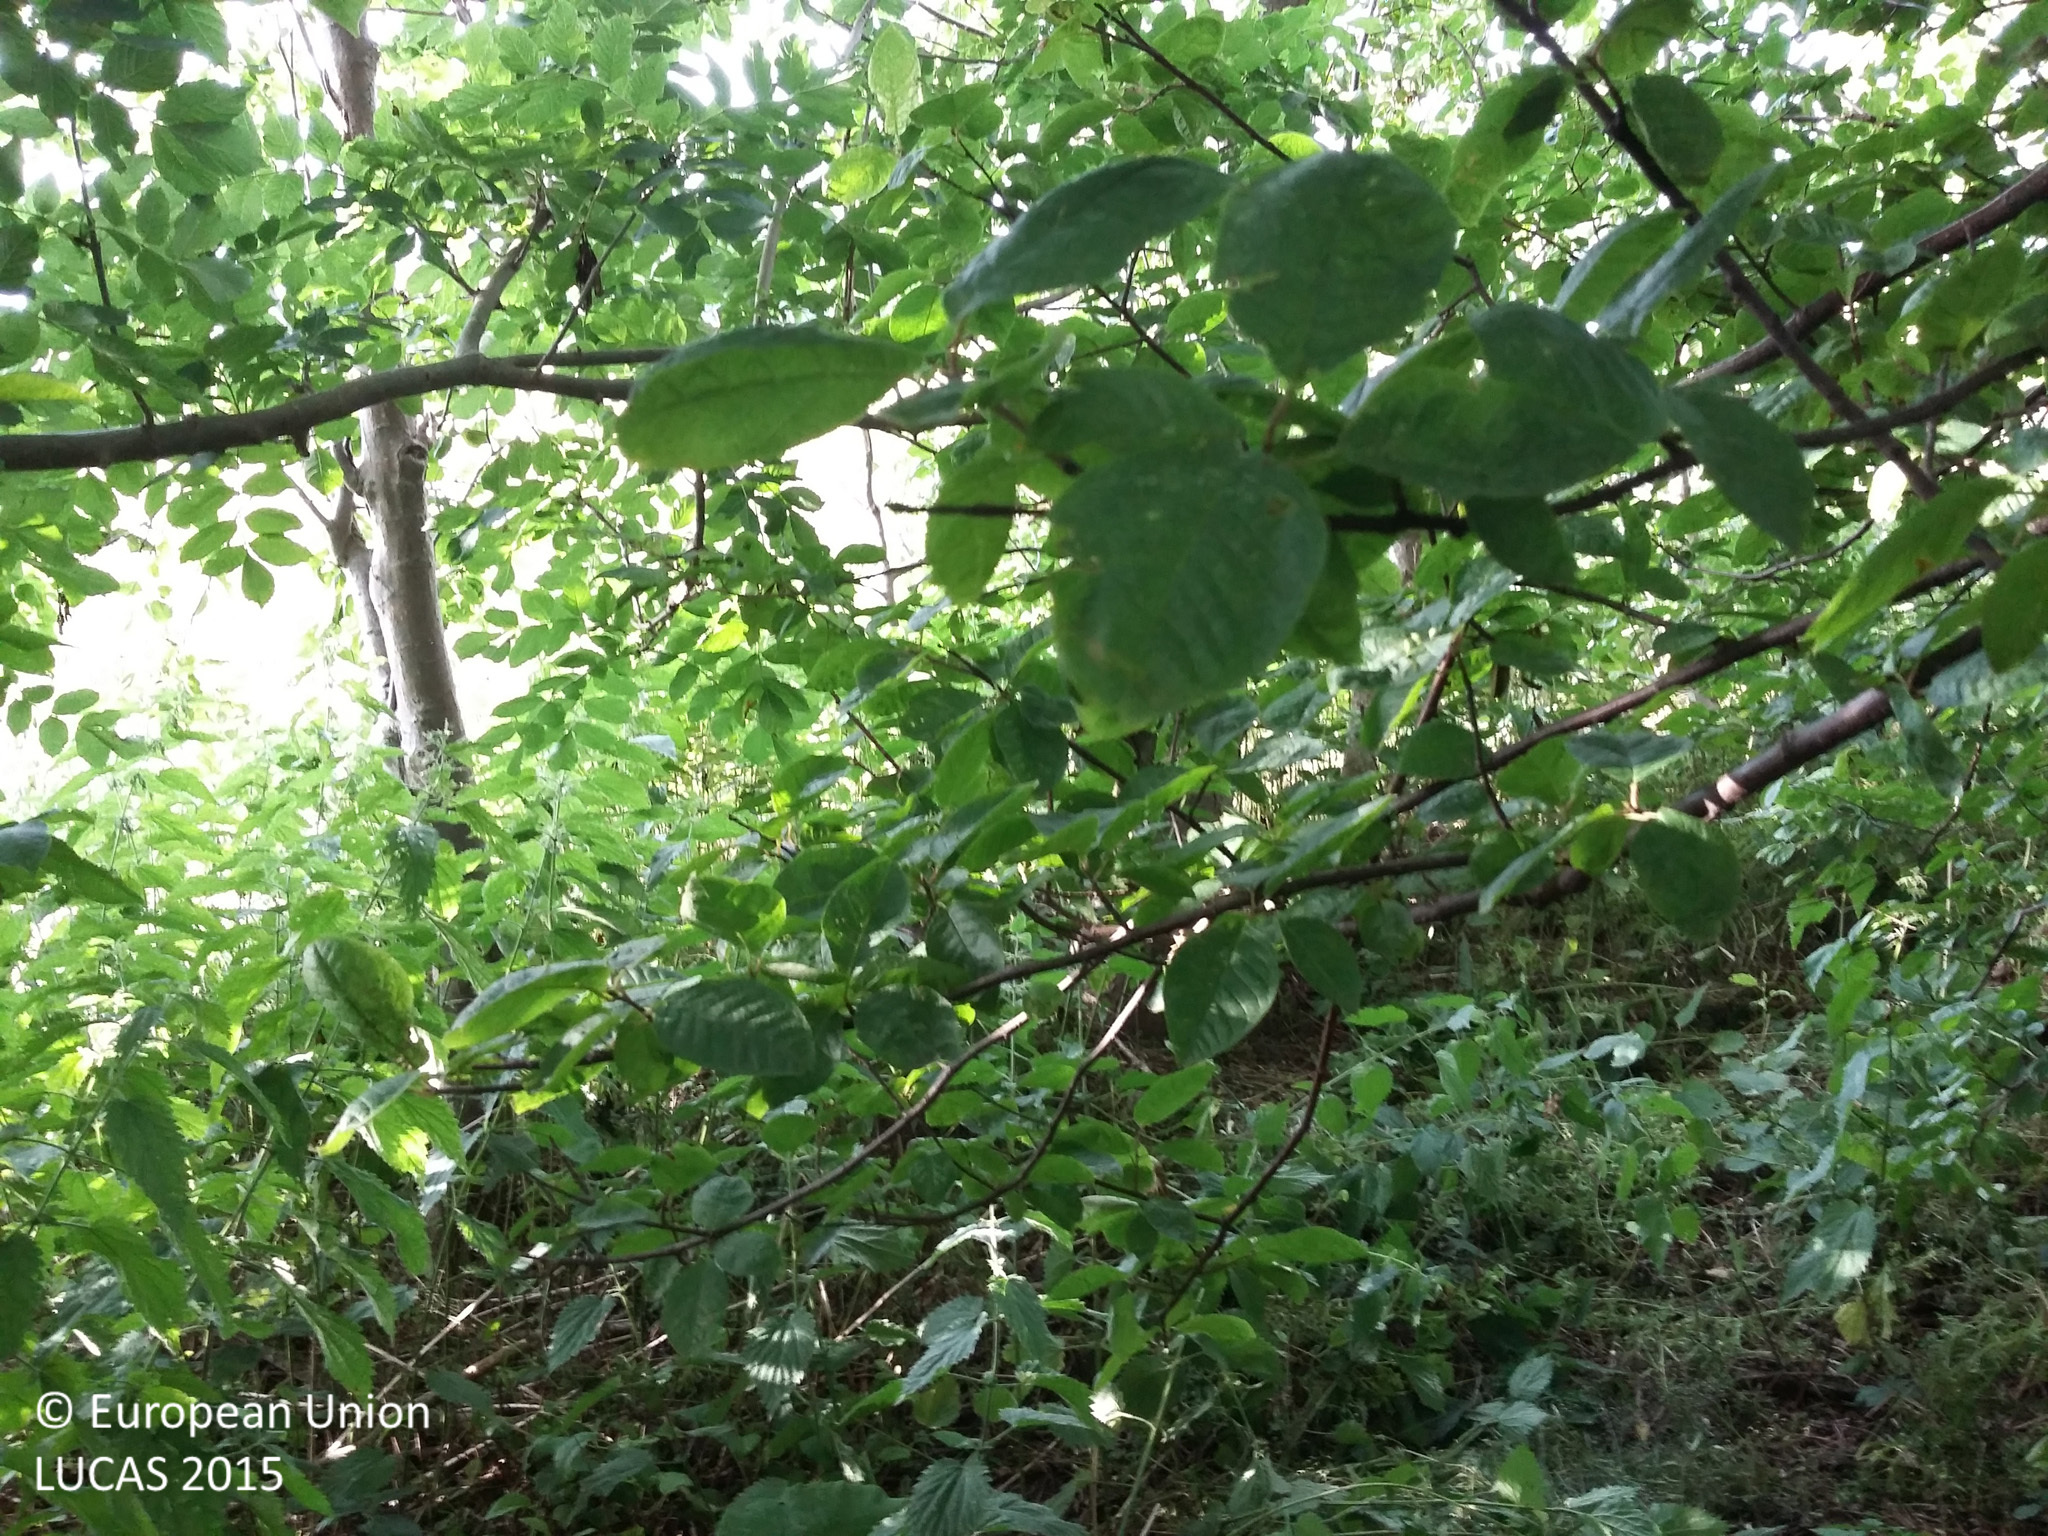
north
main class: Woodland
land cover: Broadleaved woodland
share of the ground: > 75 %
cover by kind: broadleaved forest trees 70 %, herbaceous plants 30 %
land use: Semi-natural and natural areas not in use
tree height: > 5 m
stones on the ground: < 10 %
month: July
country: DK
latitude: 55.8132
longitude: 11.9610
